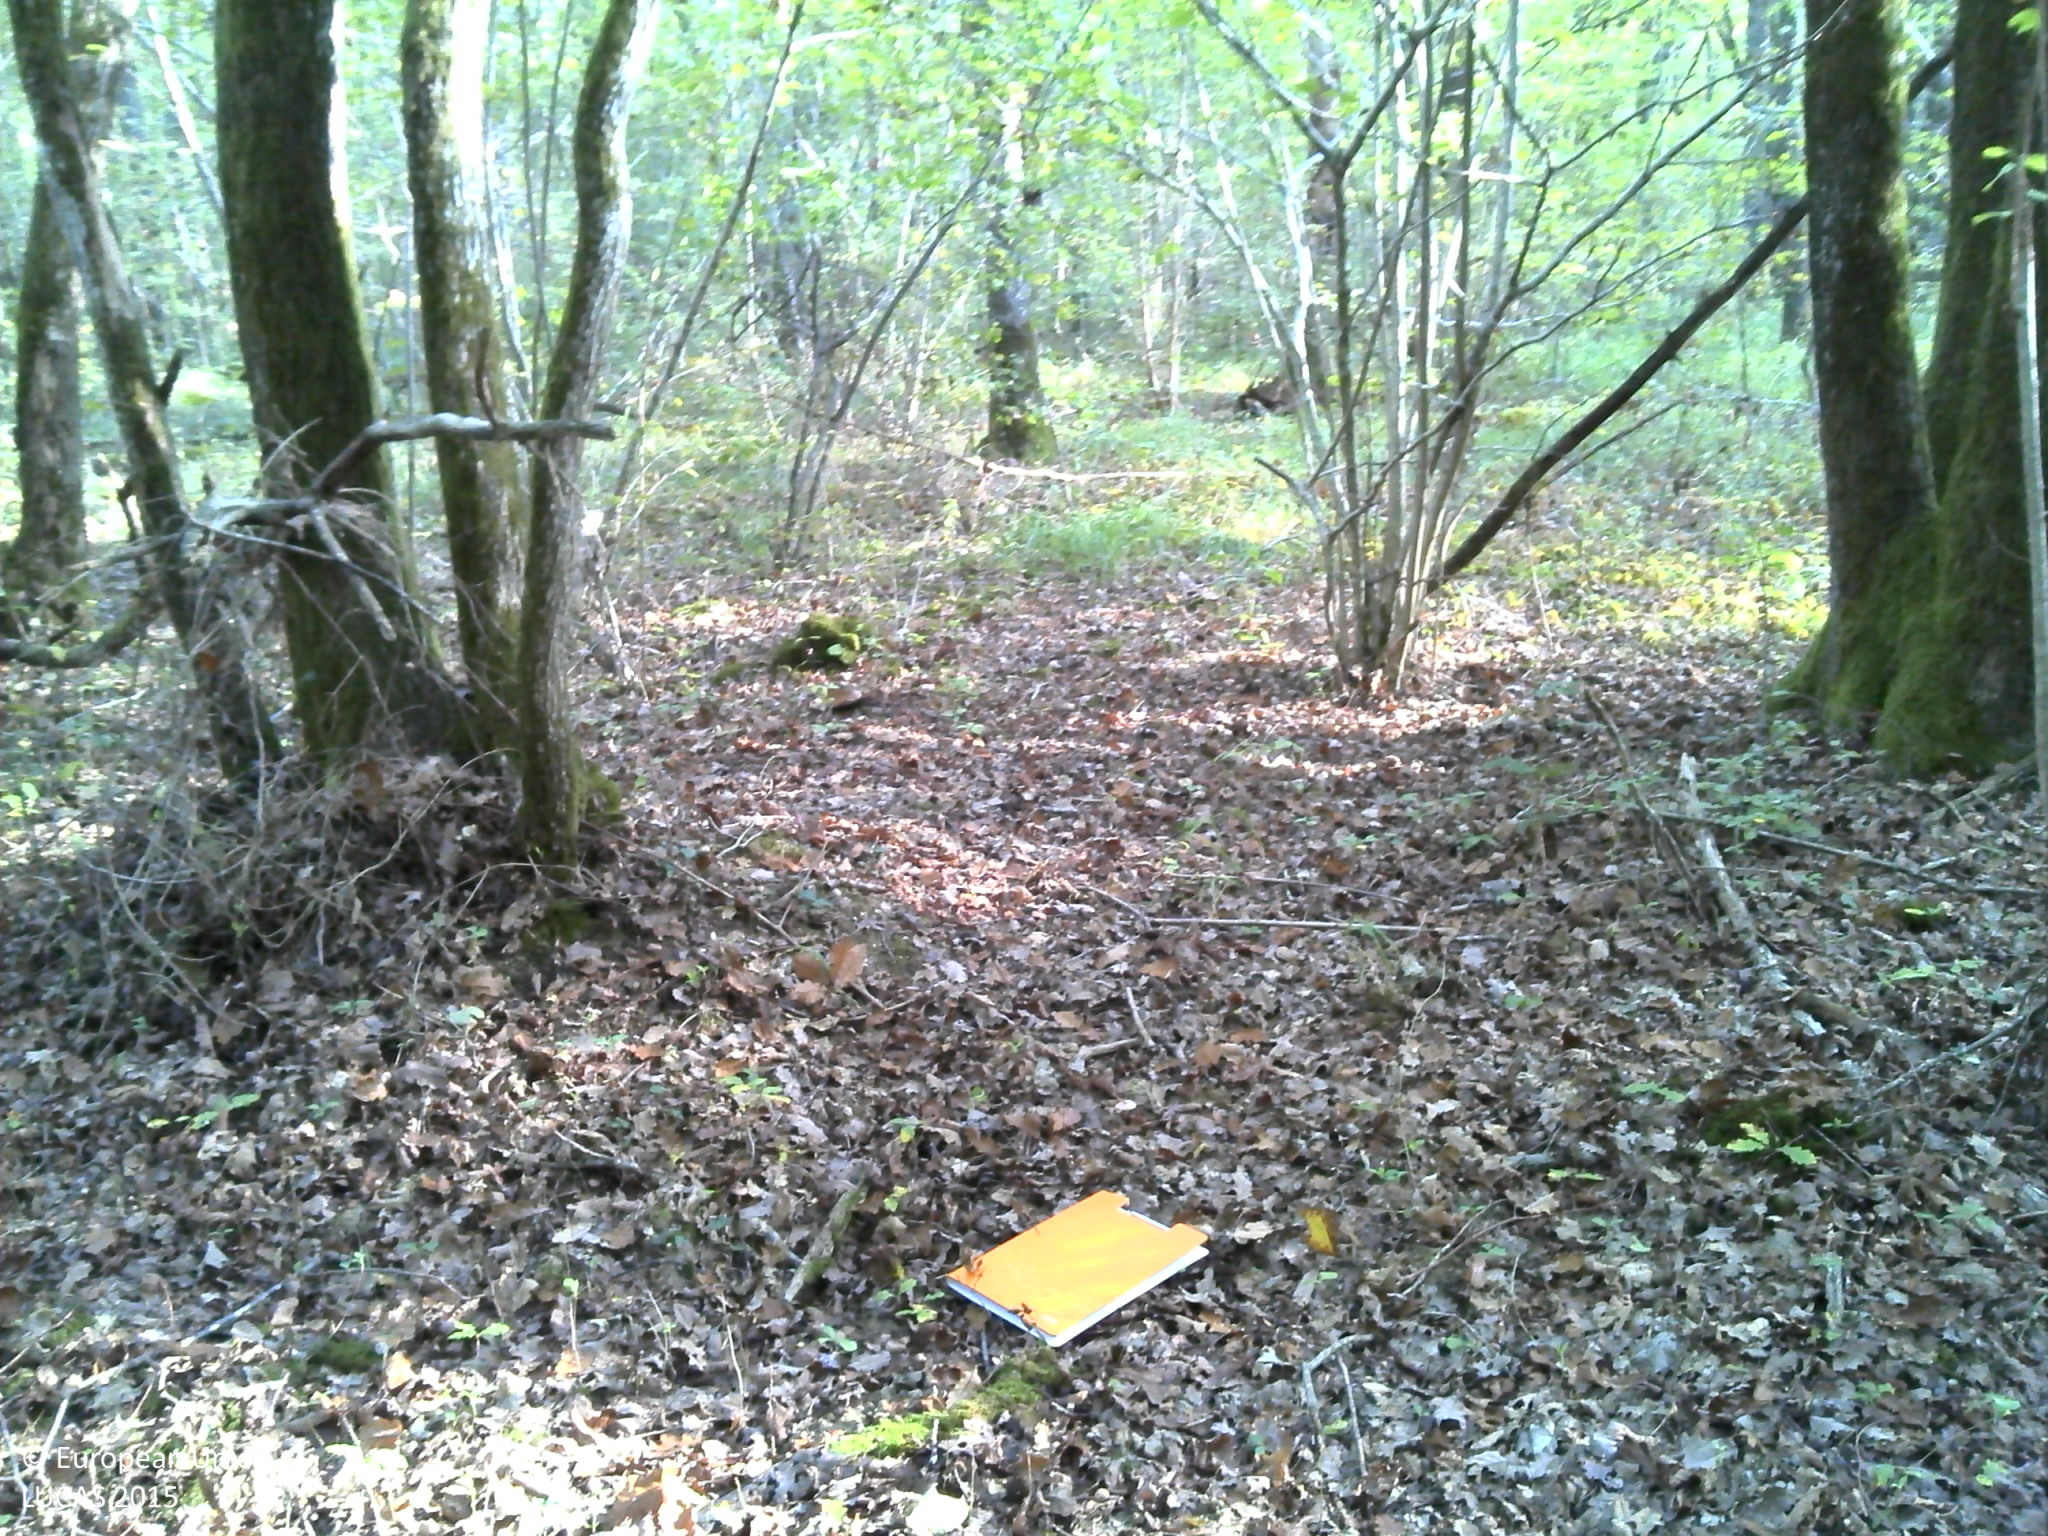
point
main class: Woodland
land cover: Broadleaved woodland
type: mesophytic deciduous forest
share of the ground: > 75 %
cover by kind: broadleaved forest trees 90 %, herbaceous plants 5 %, unconsolidated bare surface 5 %
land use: Forestry
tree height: > 5 m
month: October
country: FR
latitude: 46.2800
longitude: 6.0969
